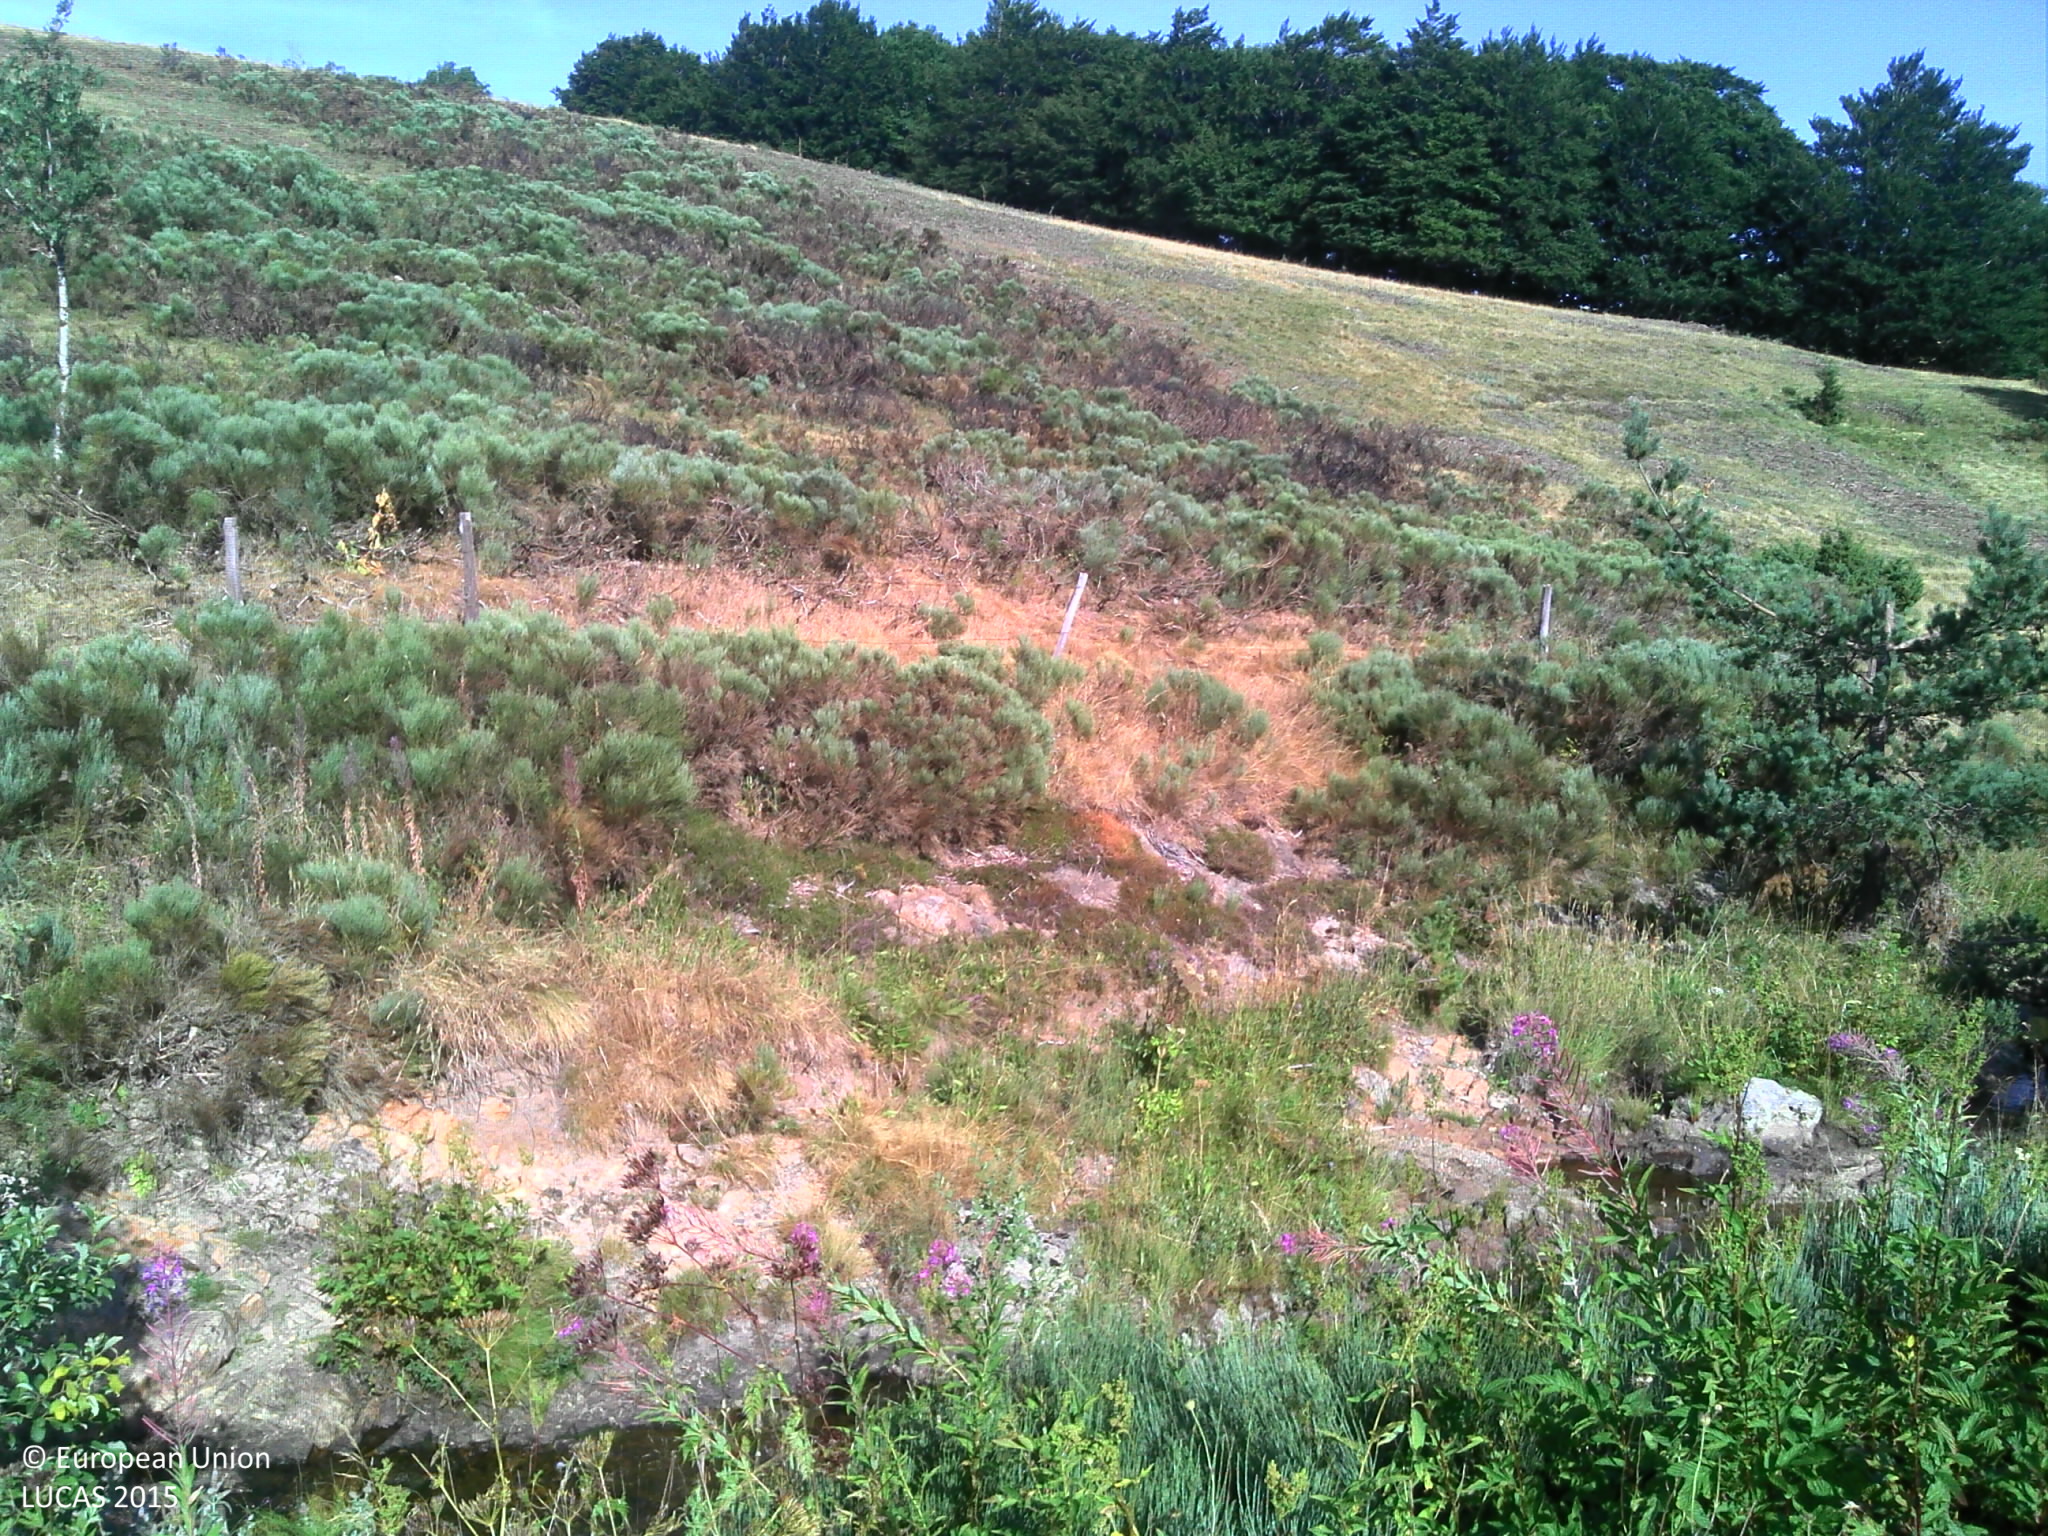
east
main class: Shrubland
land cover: Shrubland without tree cover
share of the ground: > 75 %
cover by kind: shrubs 70 %, herbaceous plants 30 %
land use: Agriculture (excluding fallow land and kitchen gardens)
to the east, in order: Shrubland without tree cover; Grassland without tree/shrub cover; Shrubland without tree cover; Grassland without tree/shrub cover; Dry stone walls; Shrubland without tree cover; Broadleaved woodland; Rivers and streams; Shrubland without tree cover; Grassland without tree/shrub cover
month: August
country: FR
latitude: 44.8390
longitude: 4.1987
